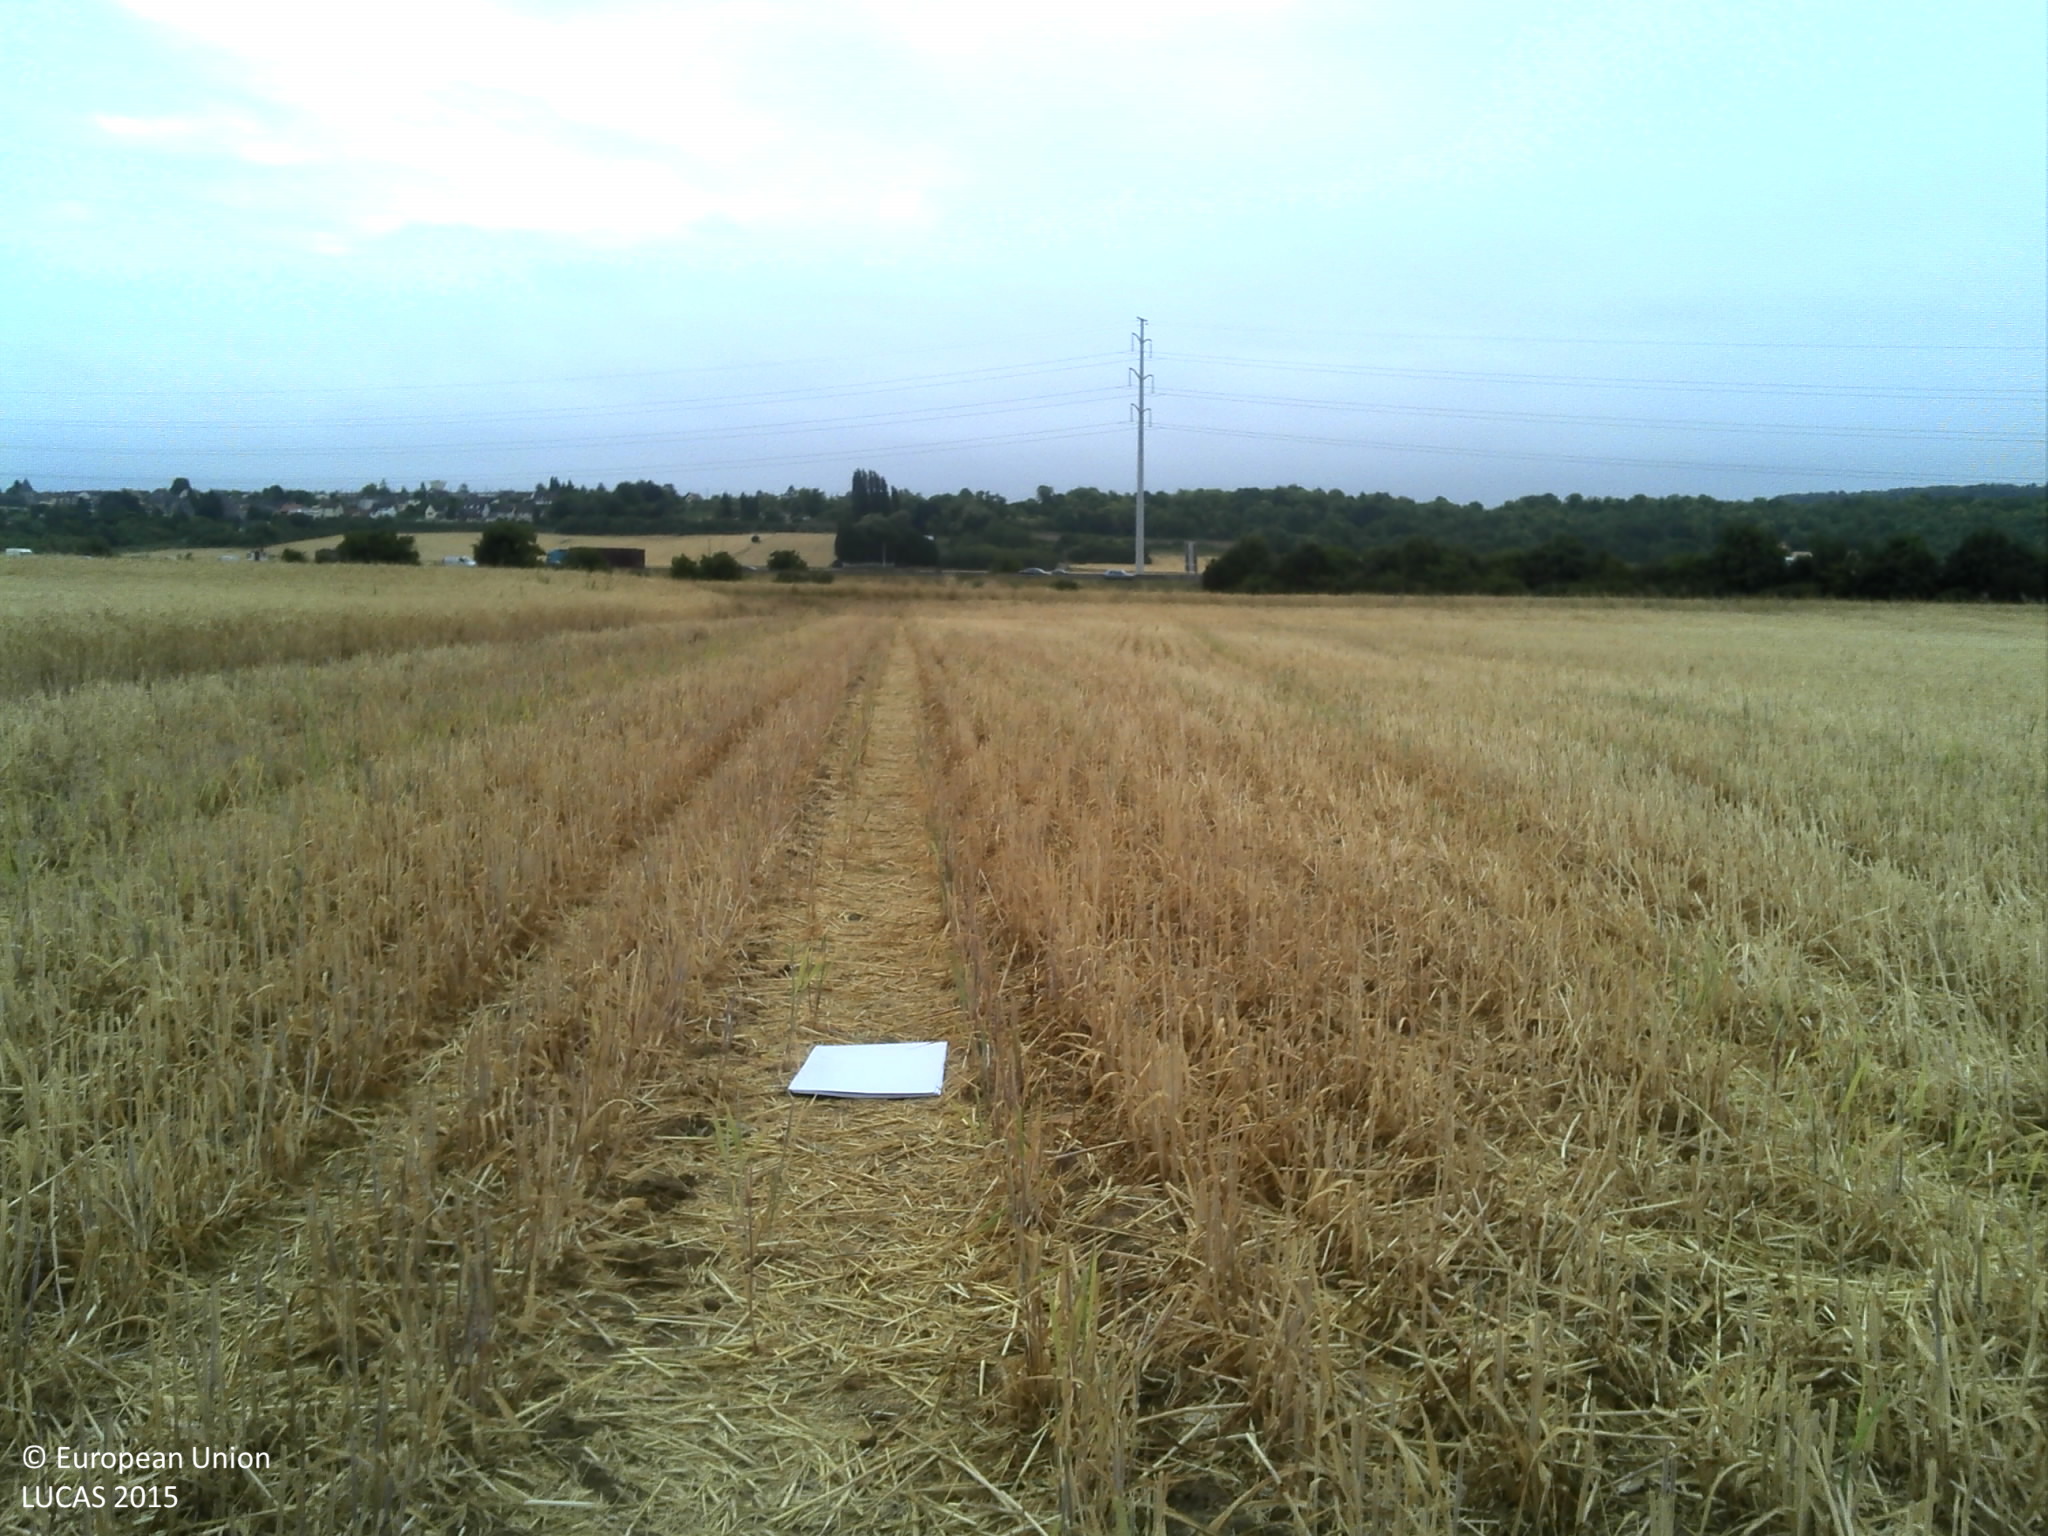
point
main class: Cropland
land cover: Barley
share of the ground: > 75 %
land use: Agriculture (excluding fallow land and kitchen gardens)
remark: Harvested field
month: July
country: FR
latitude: 48.9727
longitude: 1.8837
